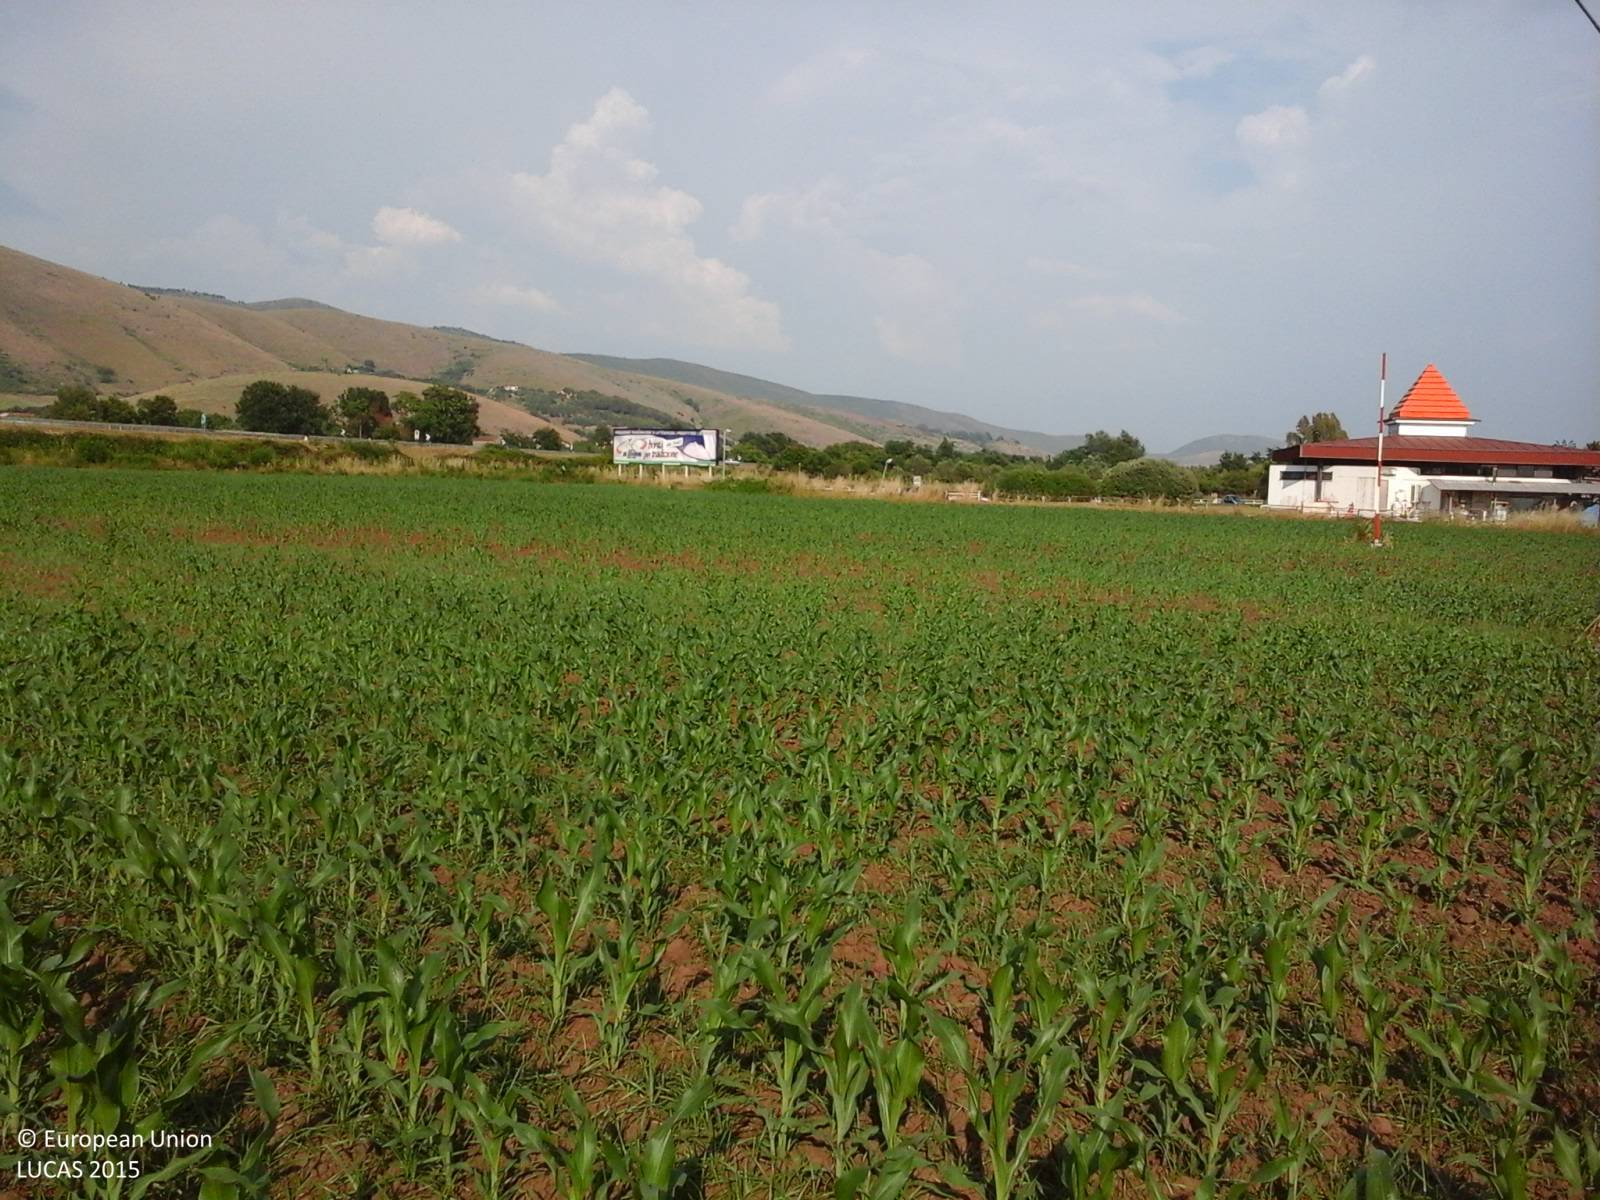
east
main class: Cropland
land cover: Maize
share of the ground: 25 - 50 %
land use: Agriculture (excluding fallow land and kitchen gardens)
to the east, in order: Maize; Electric lines; Maize; Fences; Spontaneously vegetated surfaces; Artificial constructions in urban areas; Abandoned hedges; Spontaneously vegetated surfaces
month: June
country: IT
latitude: 41.1941
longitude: 14.1450
